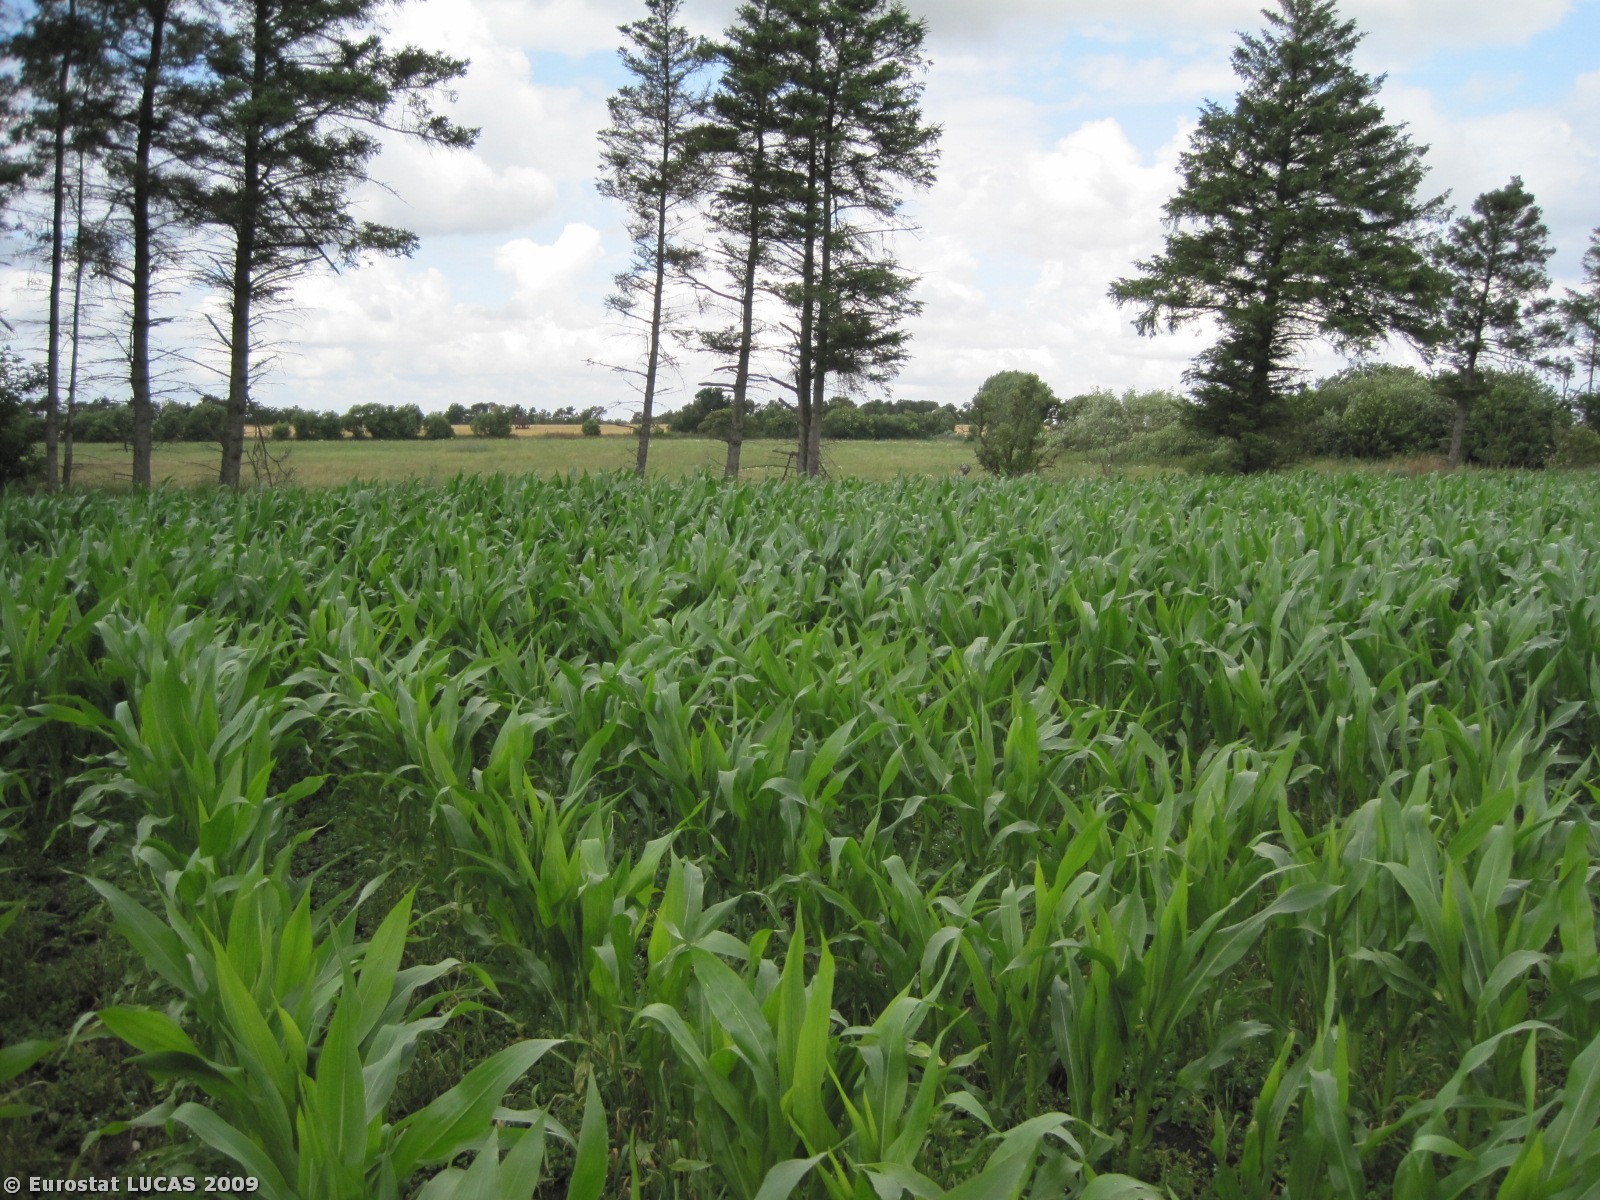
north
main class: Cropland
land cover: Maize
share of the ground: 25 - 50 %
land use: Agriculture (excluding fallow land and kitchen gardens)
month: July
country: DK
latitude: 56.4354
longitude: 8.9796
